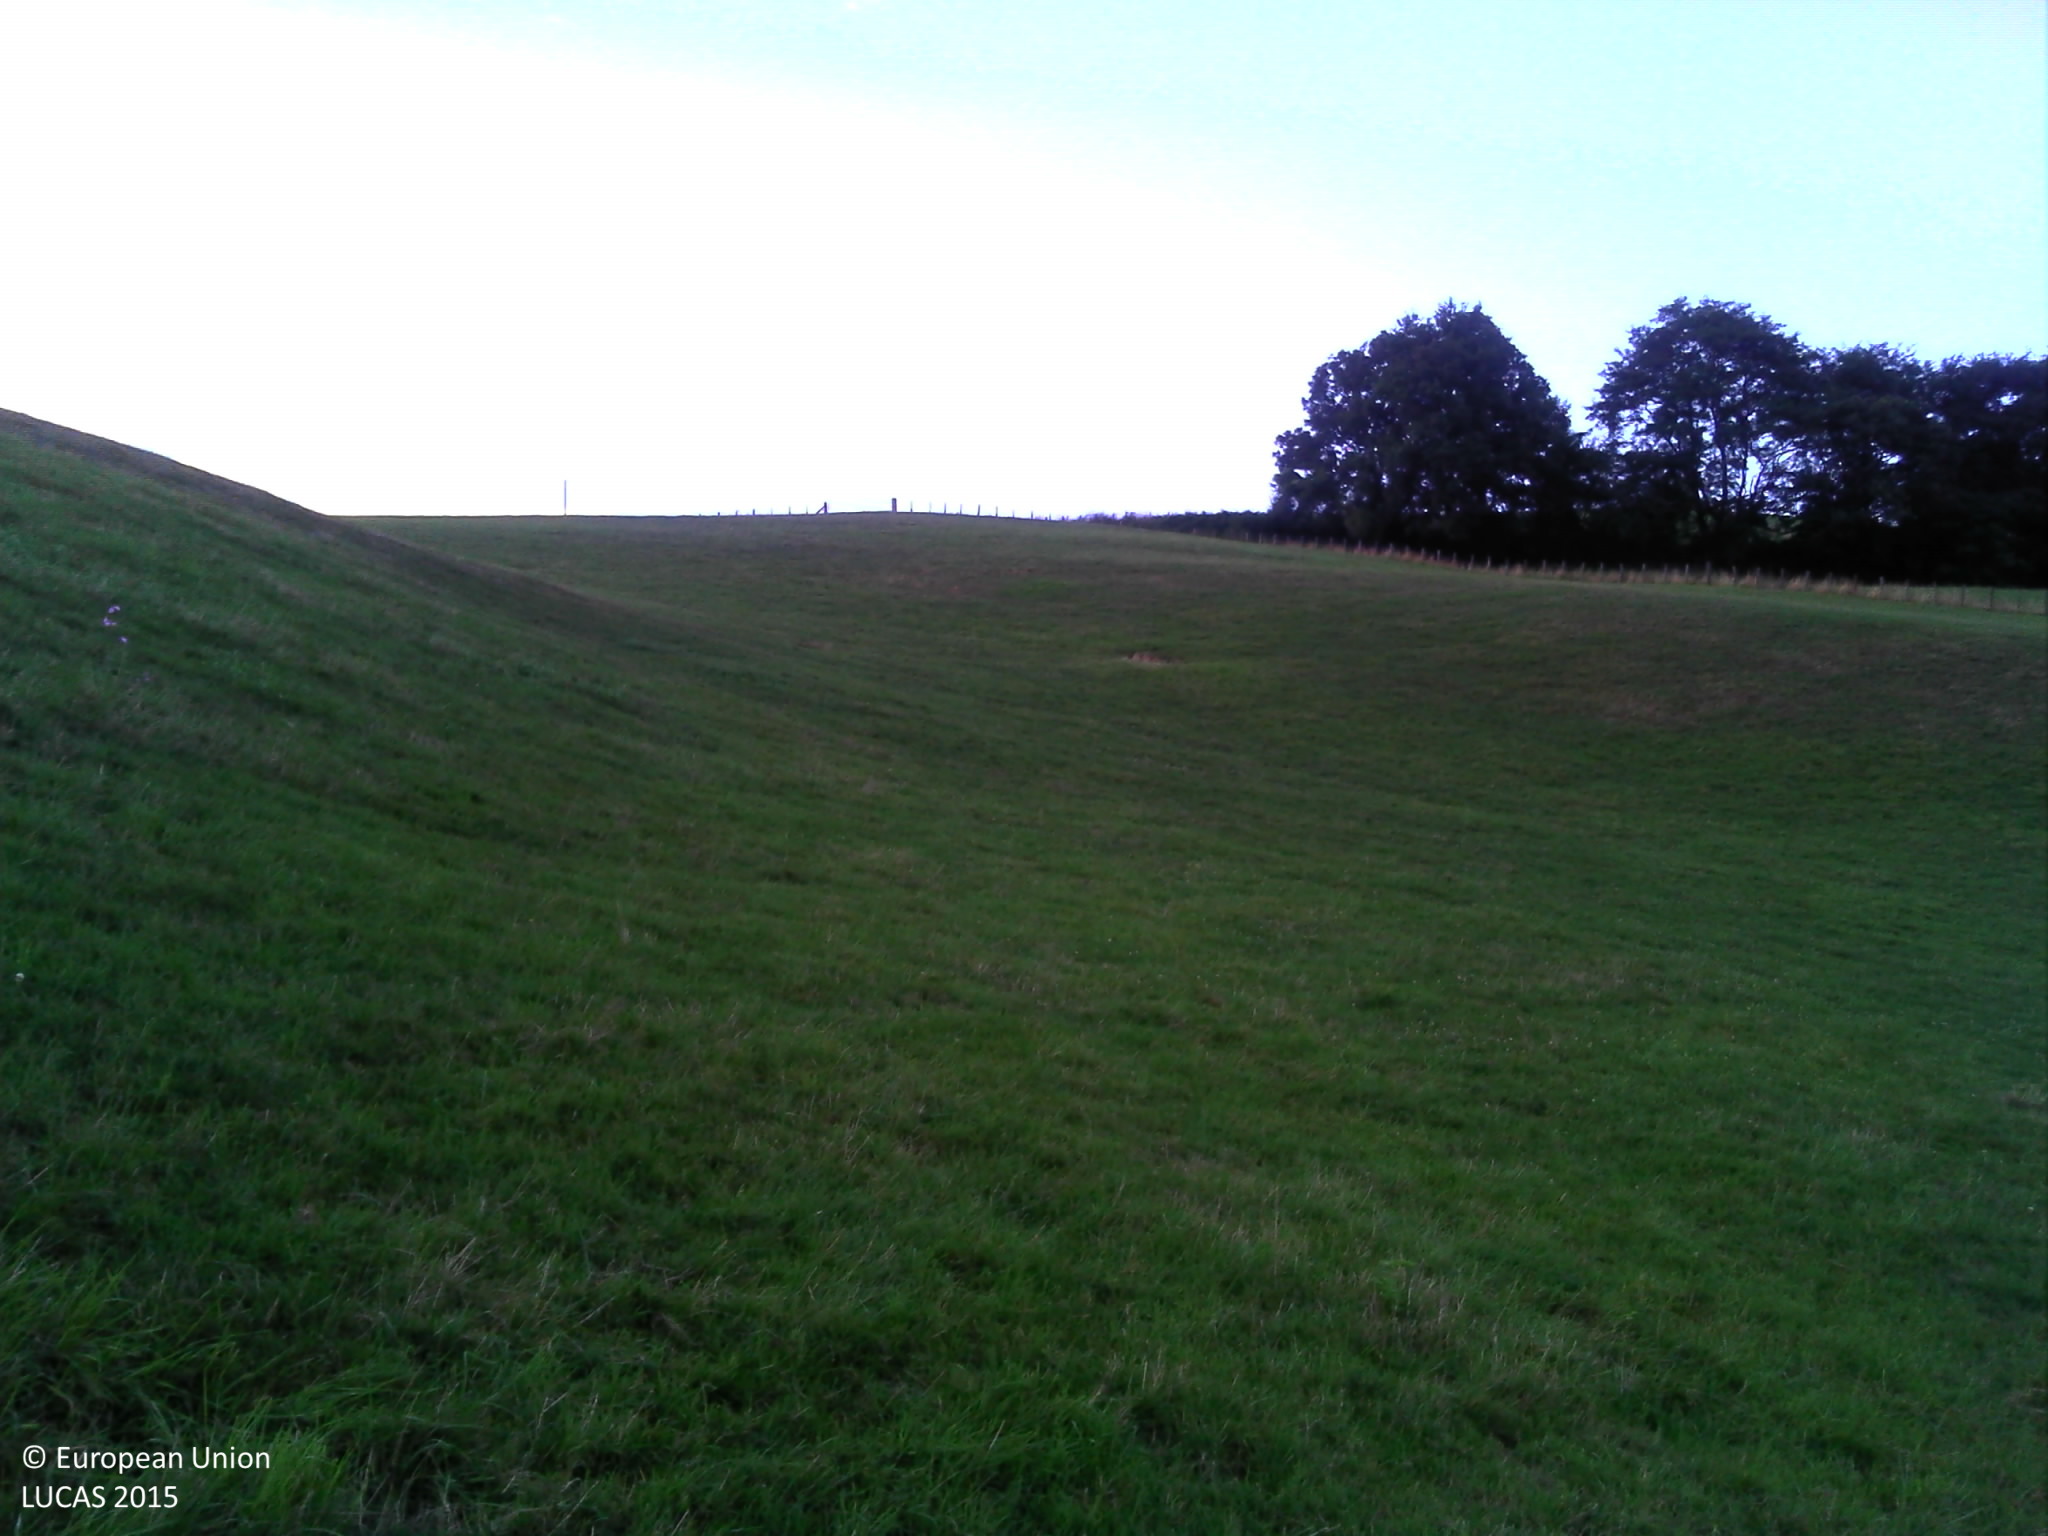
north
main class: Grassland
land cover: Grassland without tree/shrub cover
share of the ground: > 75 %
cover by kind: herbaceous plants 100 %
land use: Agriculture (excluding fallow land and kitchen gardens)
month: August
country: FR
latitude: 43.2703
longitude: -1.1888
